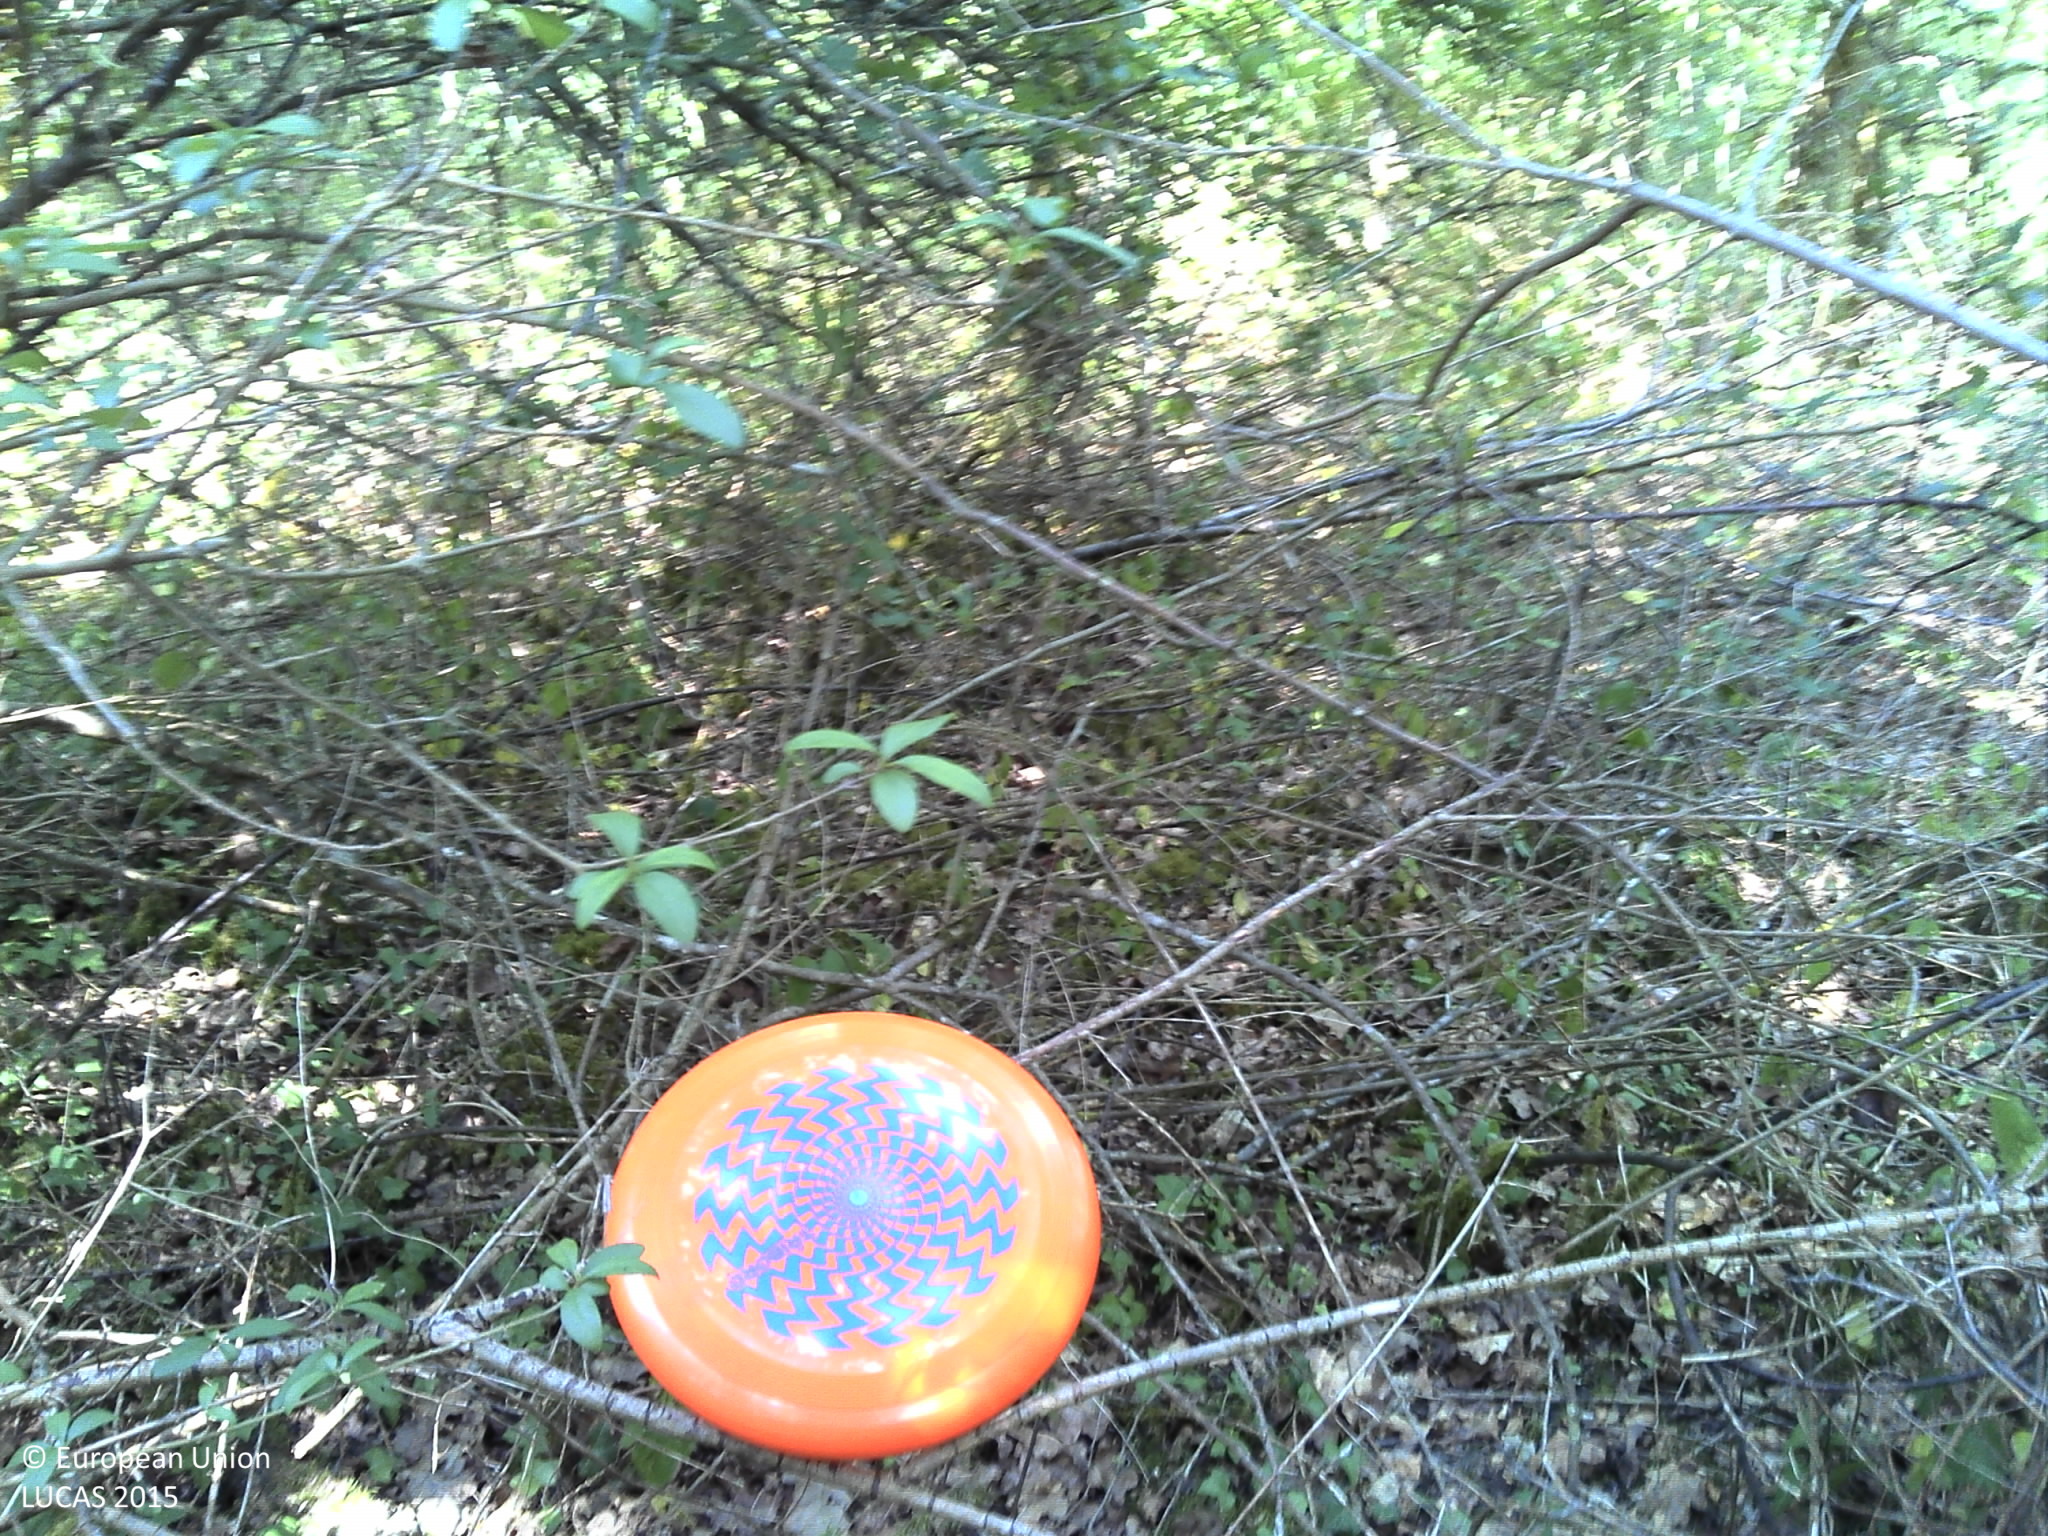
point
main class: Woodland
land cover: Broadleaved woodland
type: acidophilous oak and oak-birch forest
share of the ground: 50 - 75 %
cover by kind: broadleaved forest trees 90 %
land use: Forestry
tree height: > 5 m
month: July
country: FR
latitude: 48.4153
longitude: 2.4364
